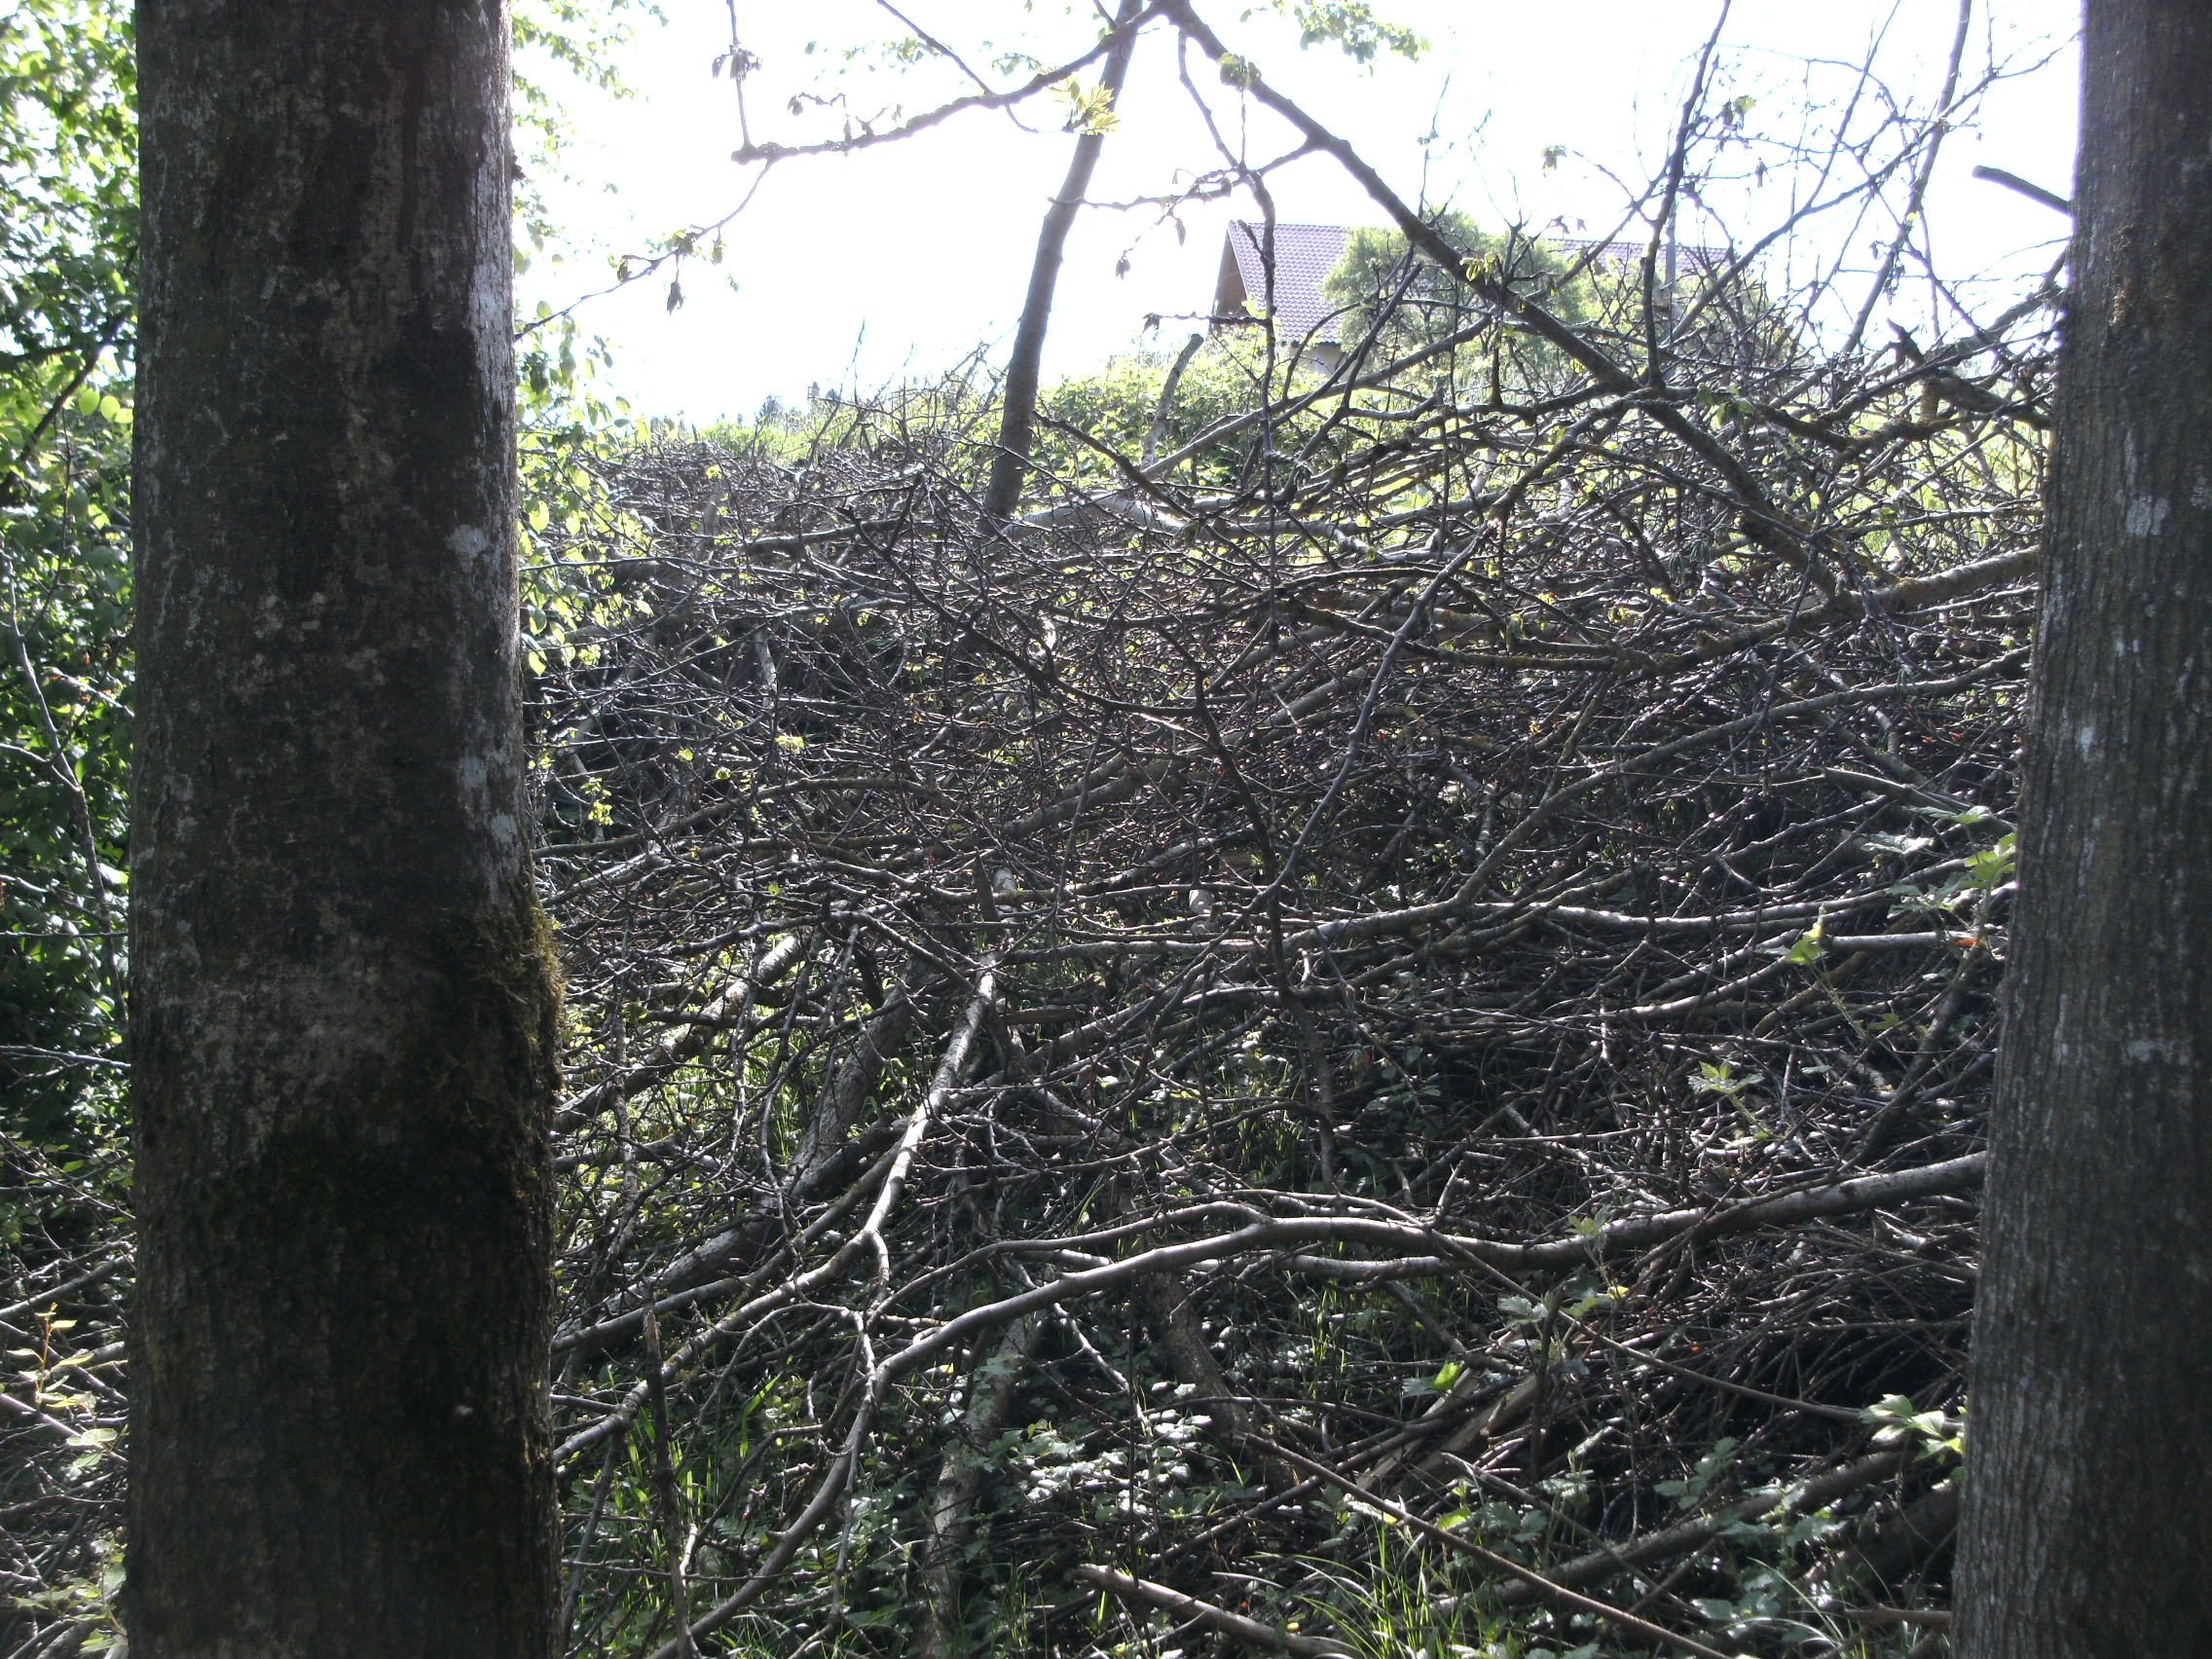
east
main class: Woodland
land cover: Other mixed woodland
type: mire and swamp forests
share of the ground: > 75 %
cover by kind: coniferous forest trees 45 %, broadleaved forest trees 45 %, shrubs 5 %, herbaceous plants 5 %
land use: Forestry
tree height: > 5 m
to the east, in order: Other mixed woodland; Grassland without tree/shrub cover; Paved roads, cycling and walking lanes; Electric lines; Paved roads, cycling and walking lanes; Grass margins; Maize; Electric lines; Maize; Grass margins; Artificial constructions in urban areas
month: May
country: AT
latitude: 48.4390
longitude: 13.4735
